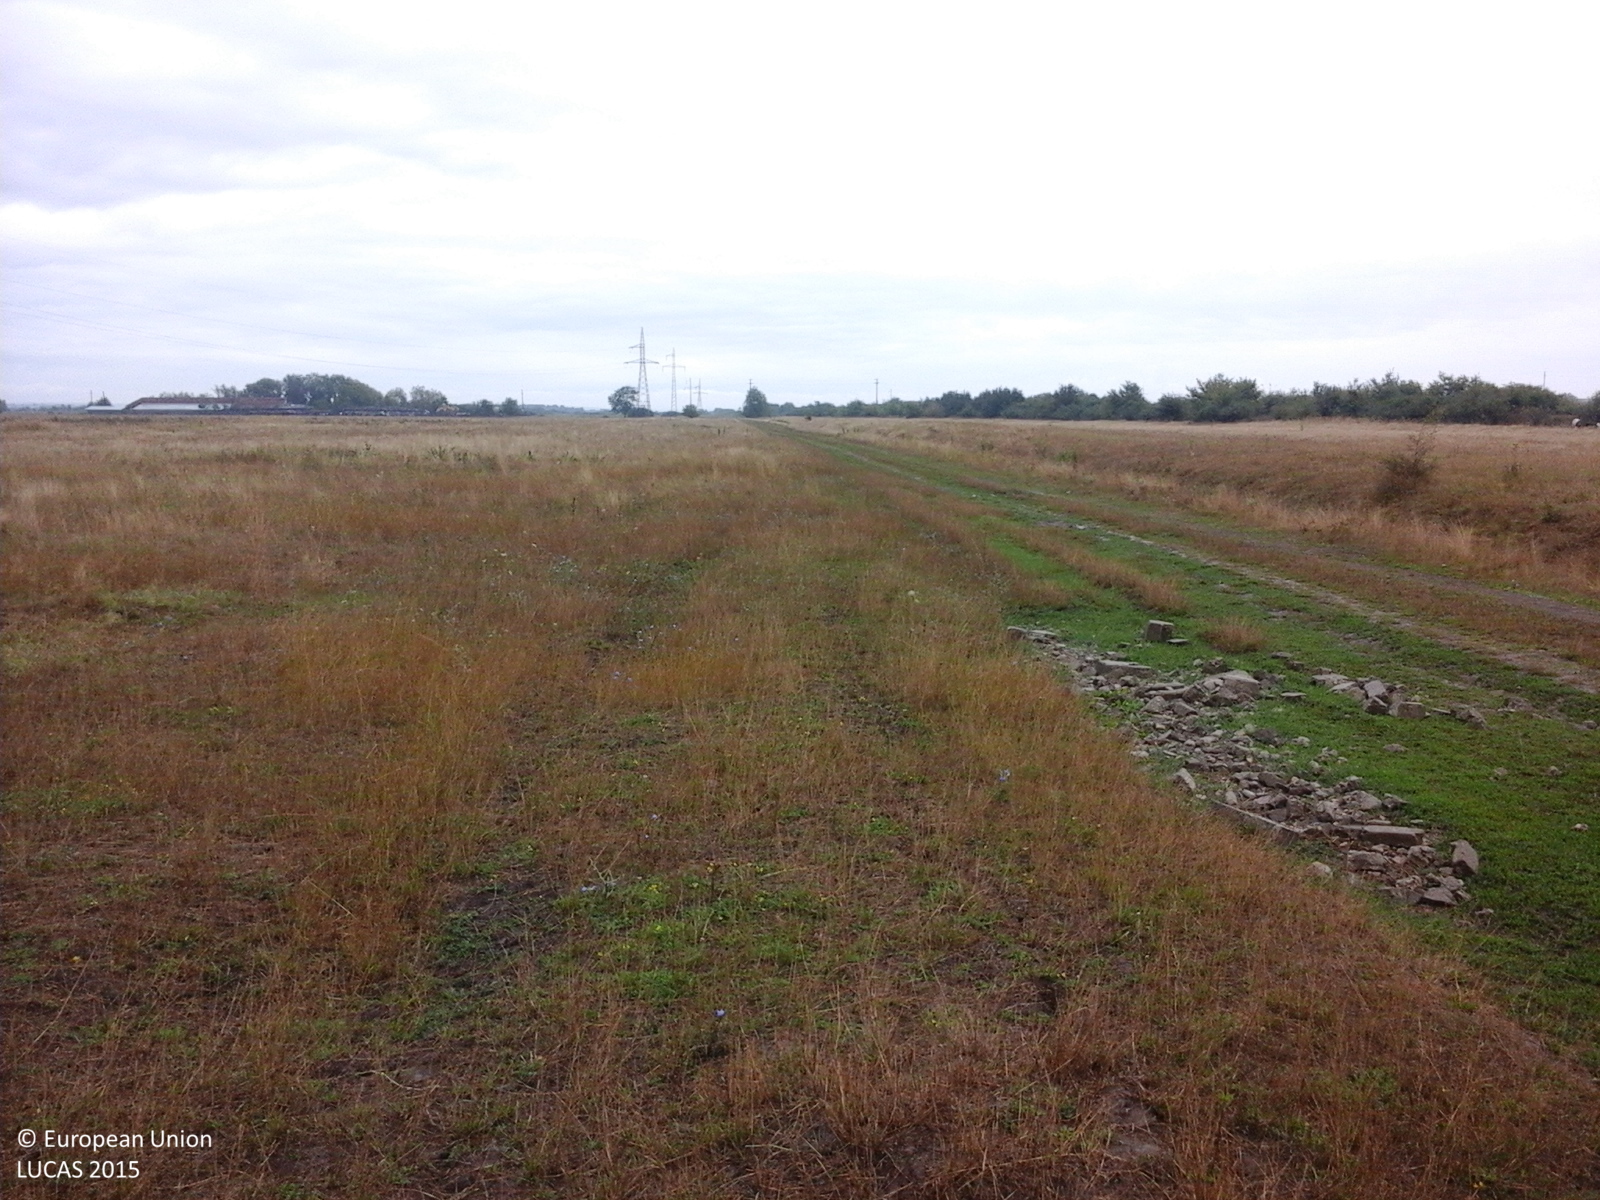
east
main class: Grassland
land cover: Grassland without tree/shrub cover
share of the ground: > 75 %
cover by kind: herbaceous plants 100 %
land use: Agriculture (excluding fallow land and kitchen gardens)
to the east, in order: Grassland without tree/shrub cover; Tracks; Grass margins; Ditches and canals; Grassland without tree/shrub cover; Tracks; Grassland without tree/shrub cover
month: August
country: RO
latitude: 45.4256
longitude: 21.4444
